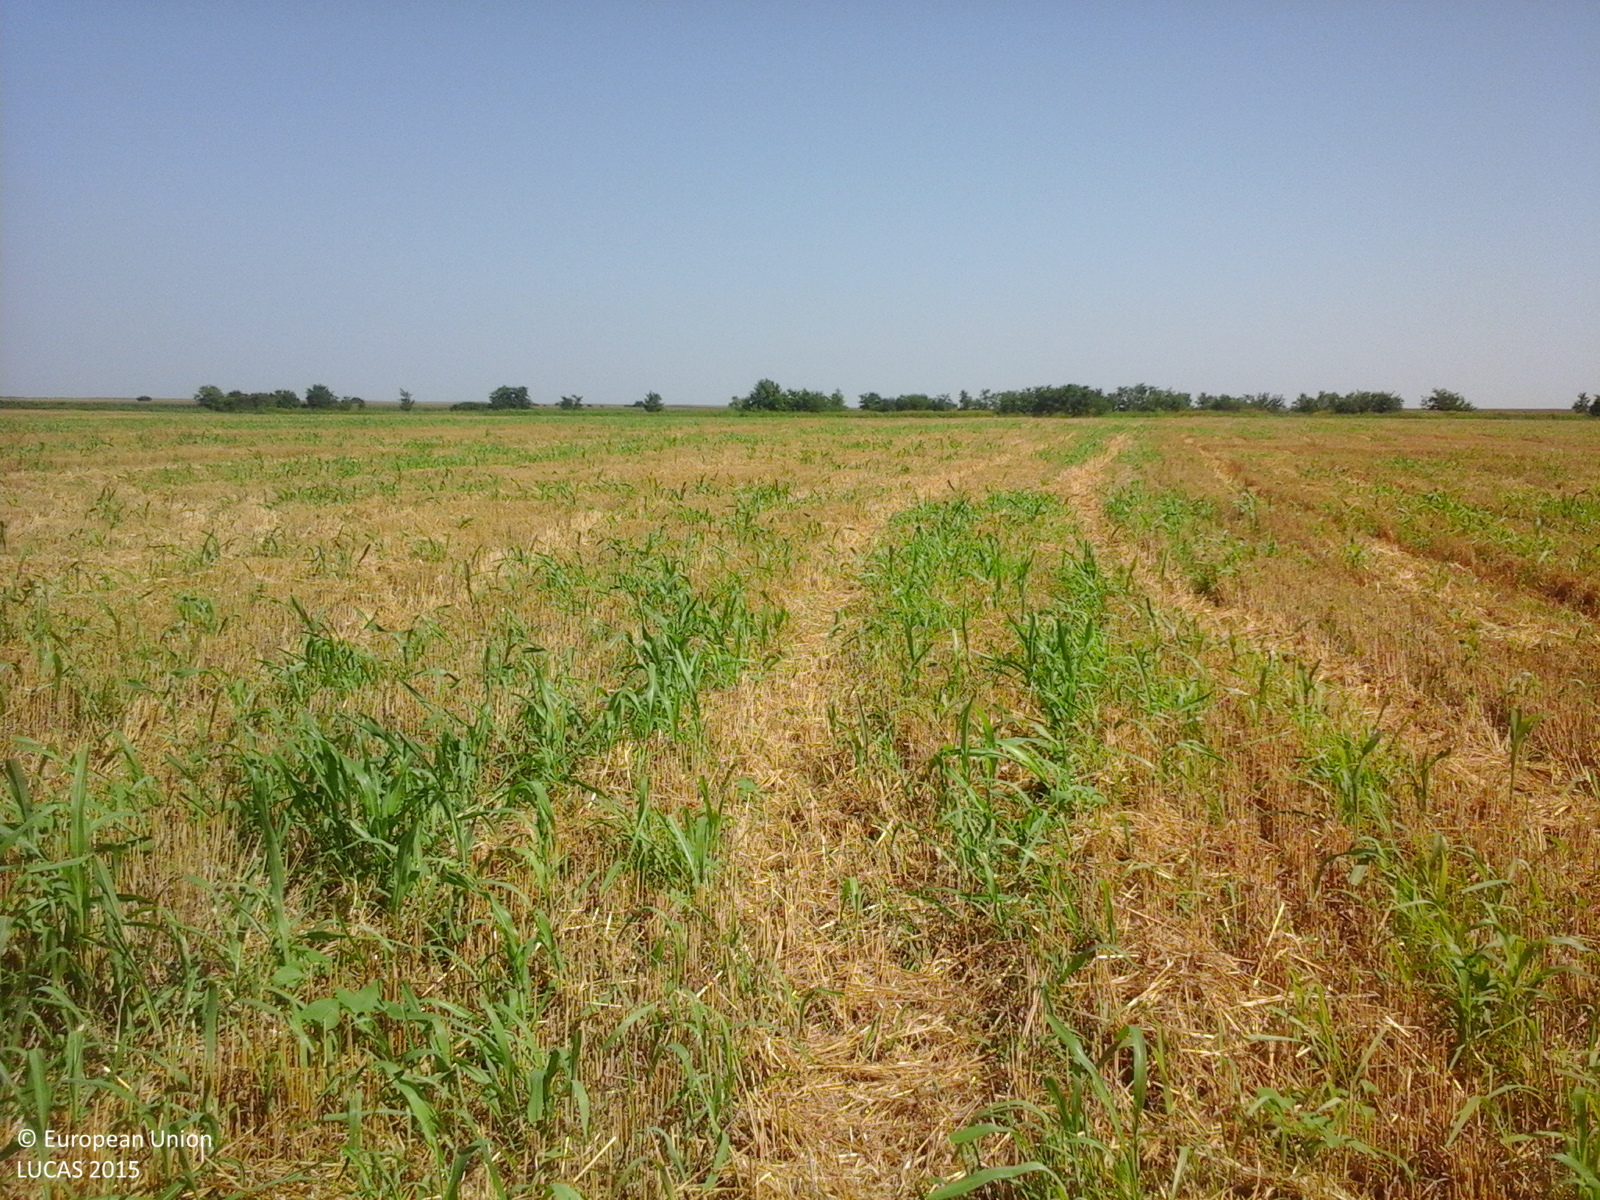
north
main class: Cropland
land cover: Durum wheat
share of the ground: 50 - 75 %
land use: Agriculture (excluding fallow land and kitchen gardens)
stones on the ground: < 10 %
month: July
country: RO
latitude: 44.4890
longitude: 27.1721
